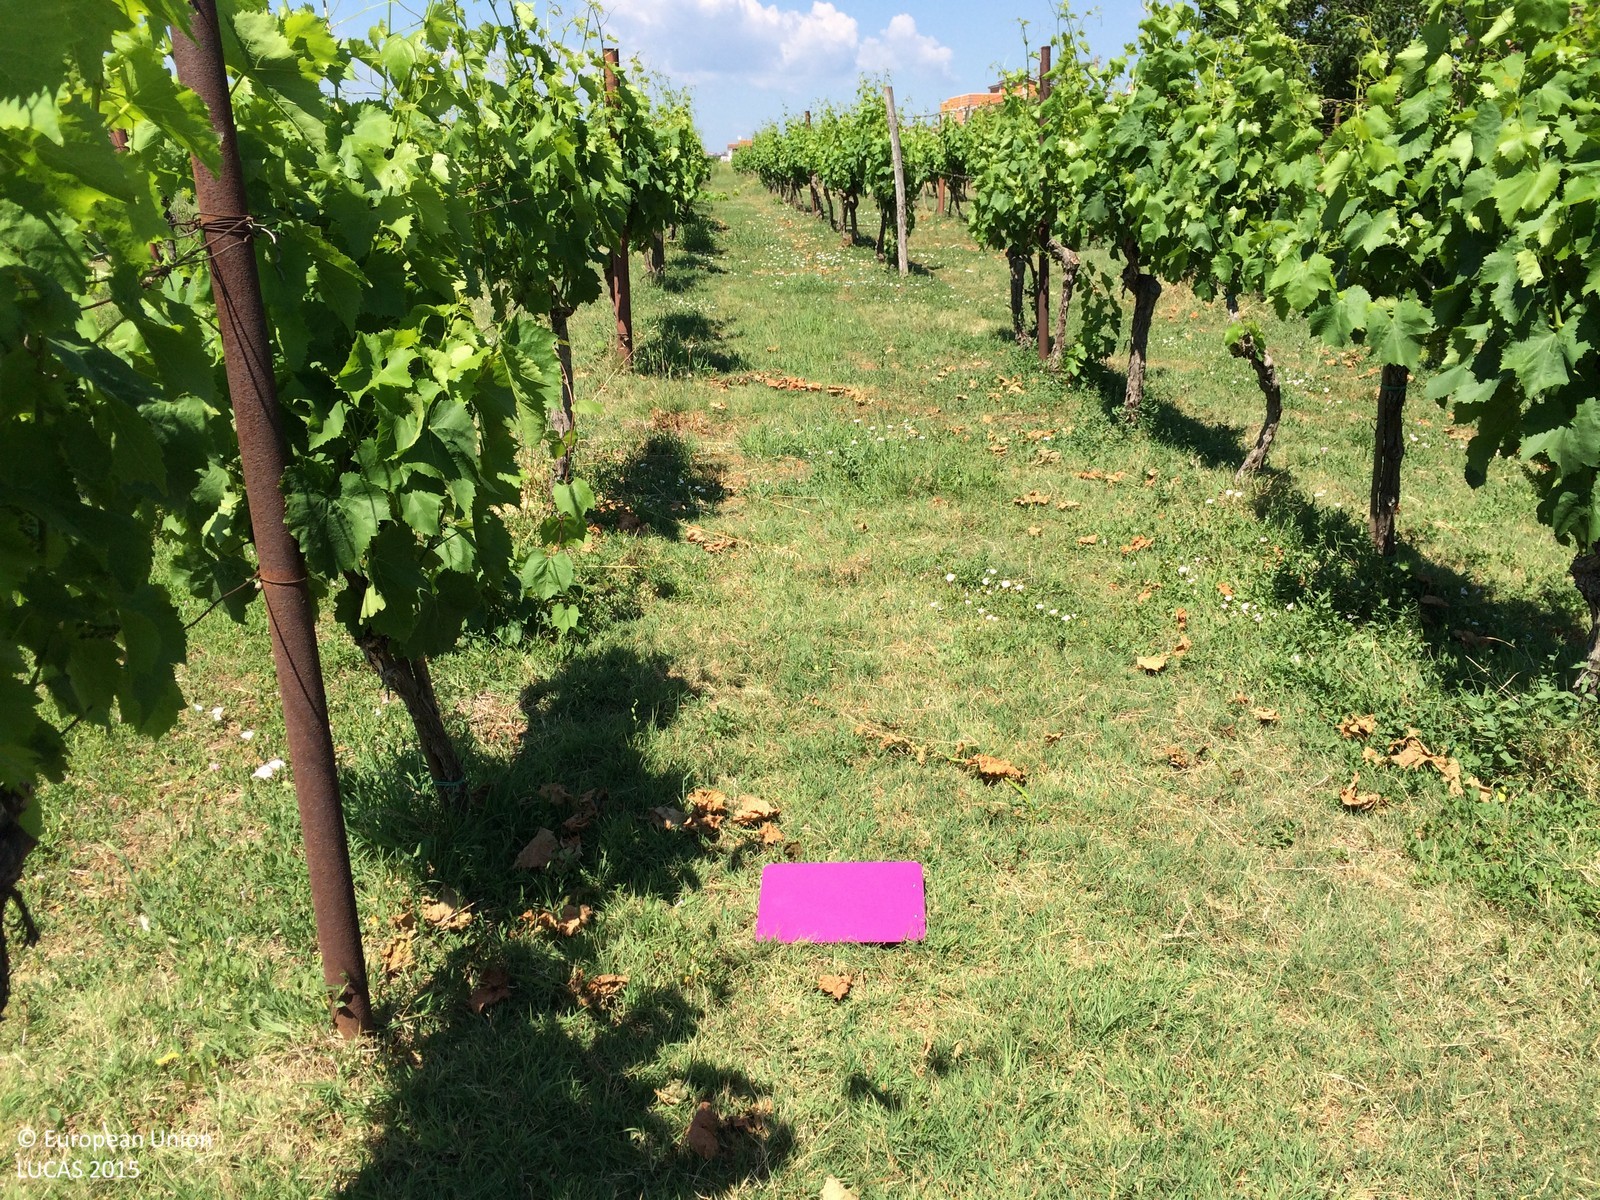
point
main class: Cropland
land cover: Vineyards
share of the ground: 50 - 75 %
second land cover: Grassland without tree/shrub cover
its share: 50 - 75 %
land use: Agriculture (excluding fallow land and kitchen gardens)
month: June
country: HR
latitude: 44.9116
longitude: 13.8321
